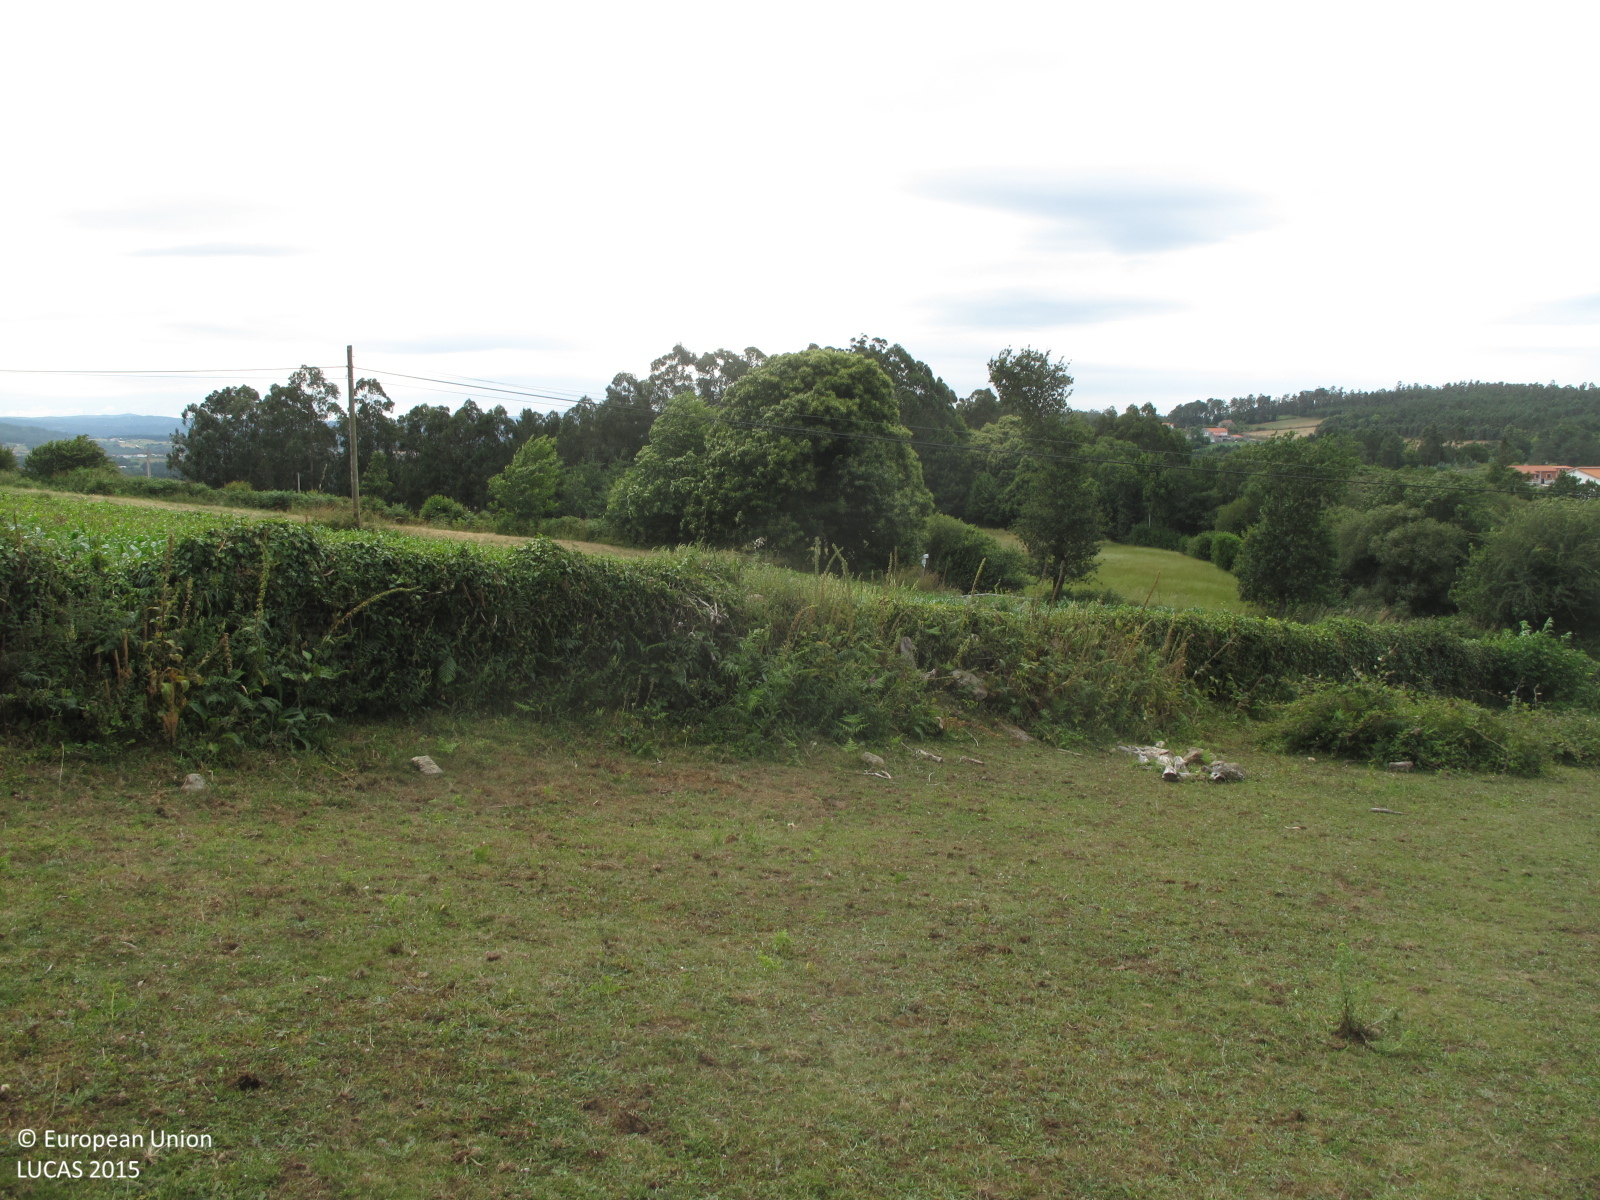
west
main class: Grassland
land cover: Grassland without tree/shrub cover
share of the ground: > 75 %
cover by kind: herbaceous plants 80 %, unconsolidated bare surface 20 %
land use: Agriculture (excluding fallow land and kitchen gardens)
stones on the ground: < 10 %
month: July
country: ES
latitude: 43.2075
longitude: -8.5851
